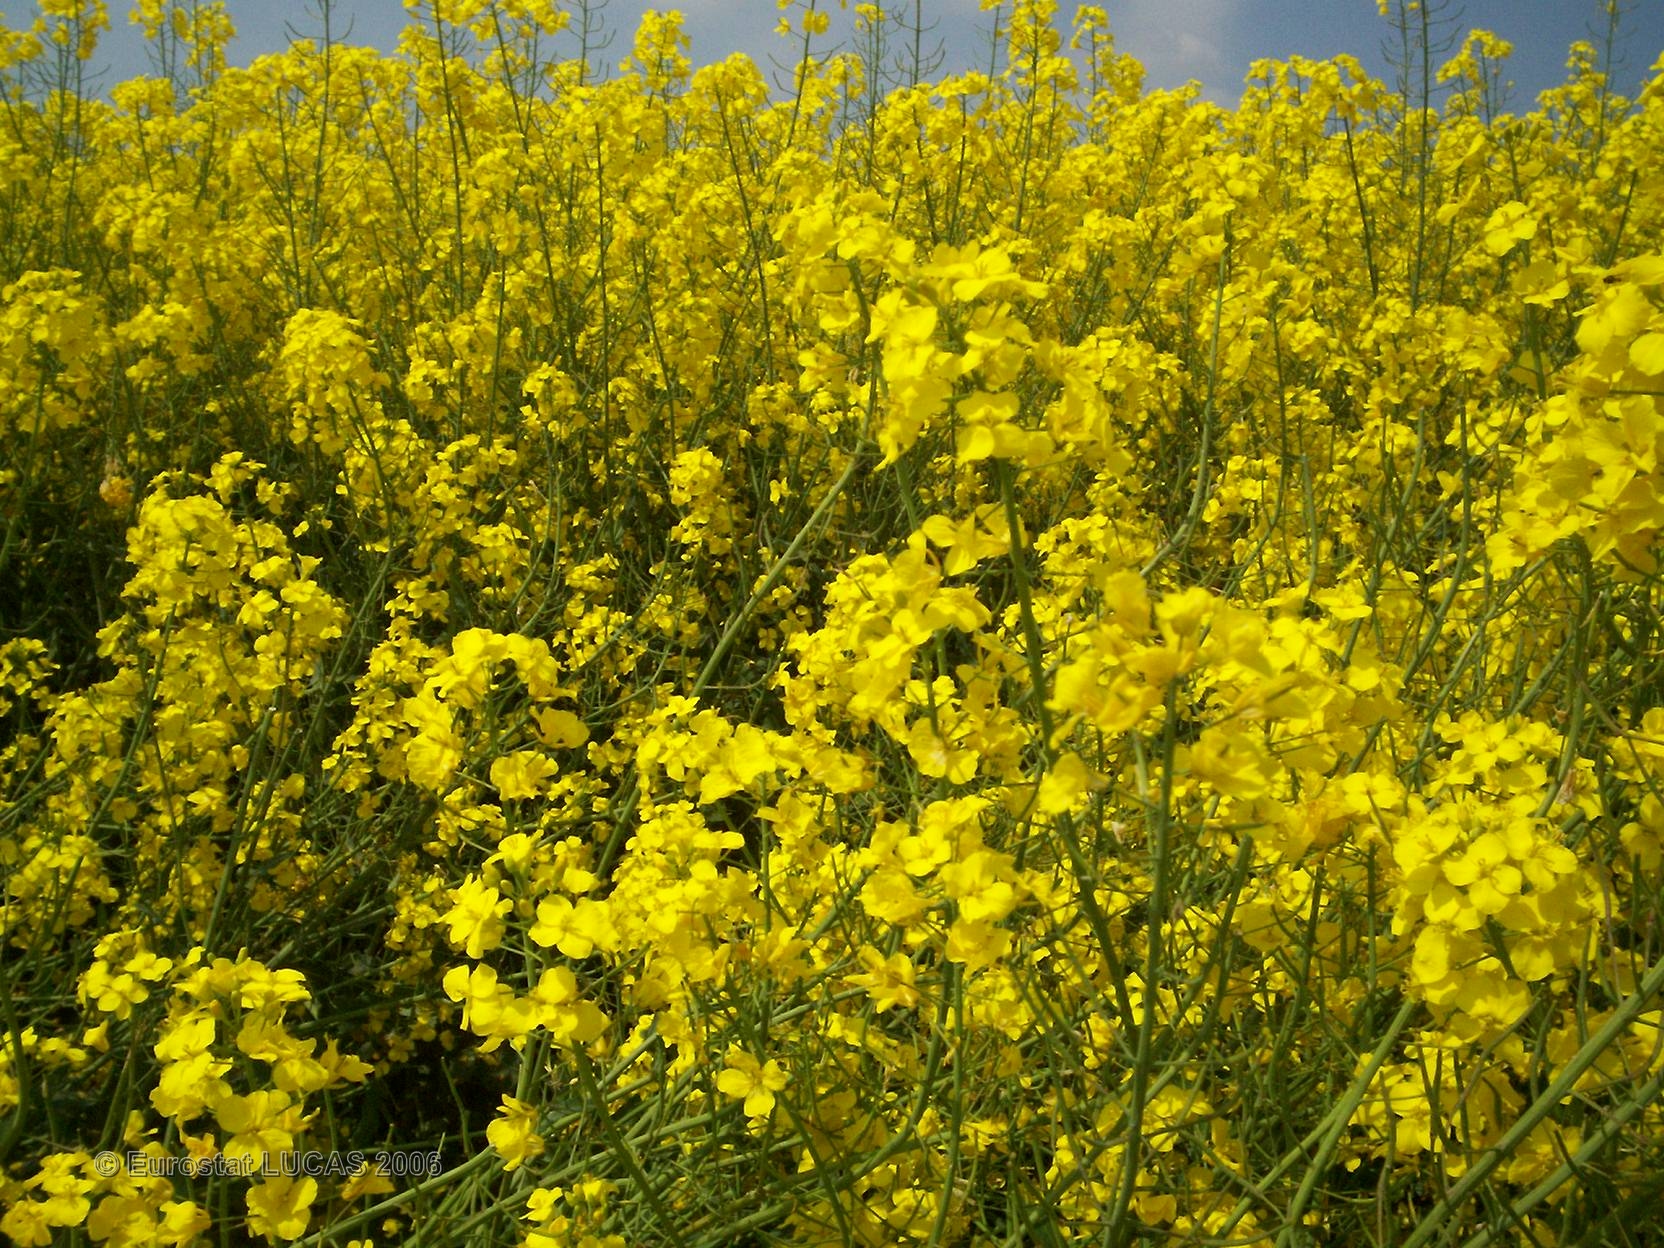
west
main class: Cropland
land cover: Rape and turnip rape
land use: Agriculture (excluding fallow land and kitchen gardens)
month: May
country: FR
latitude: 49.2287
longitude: 0.5402
